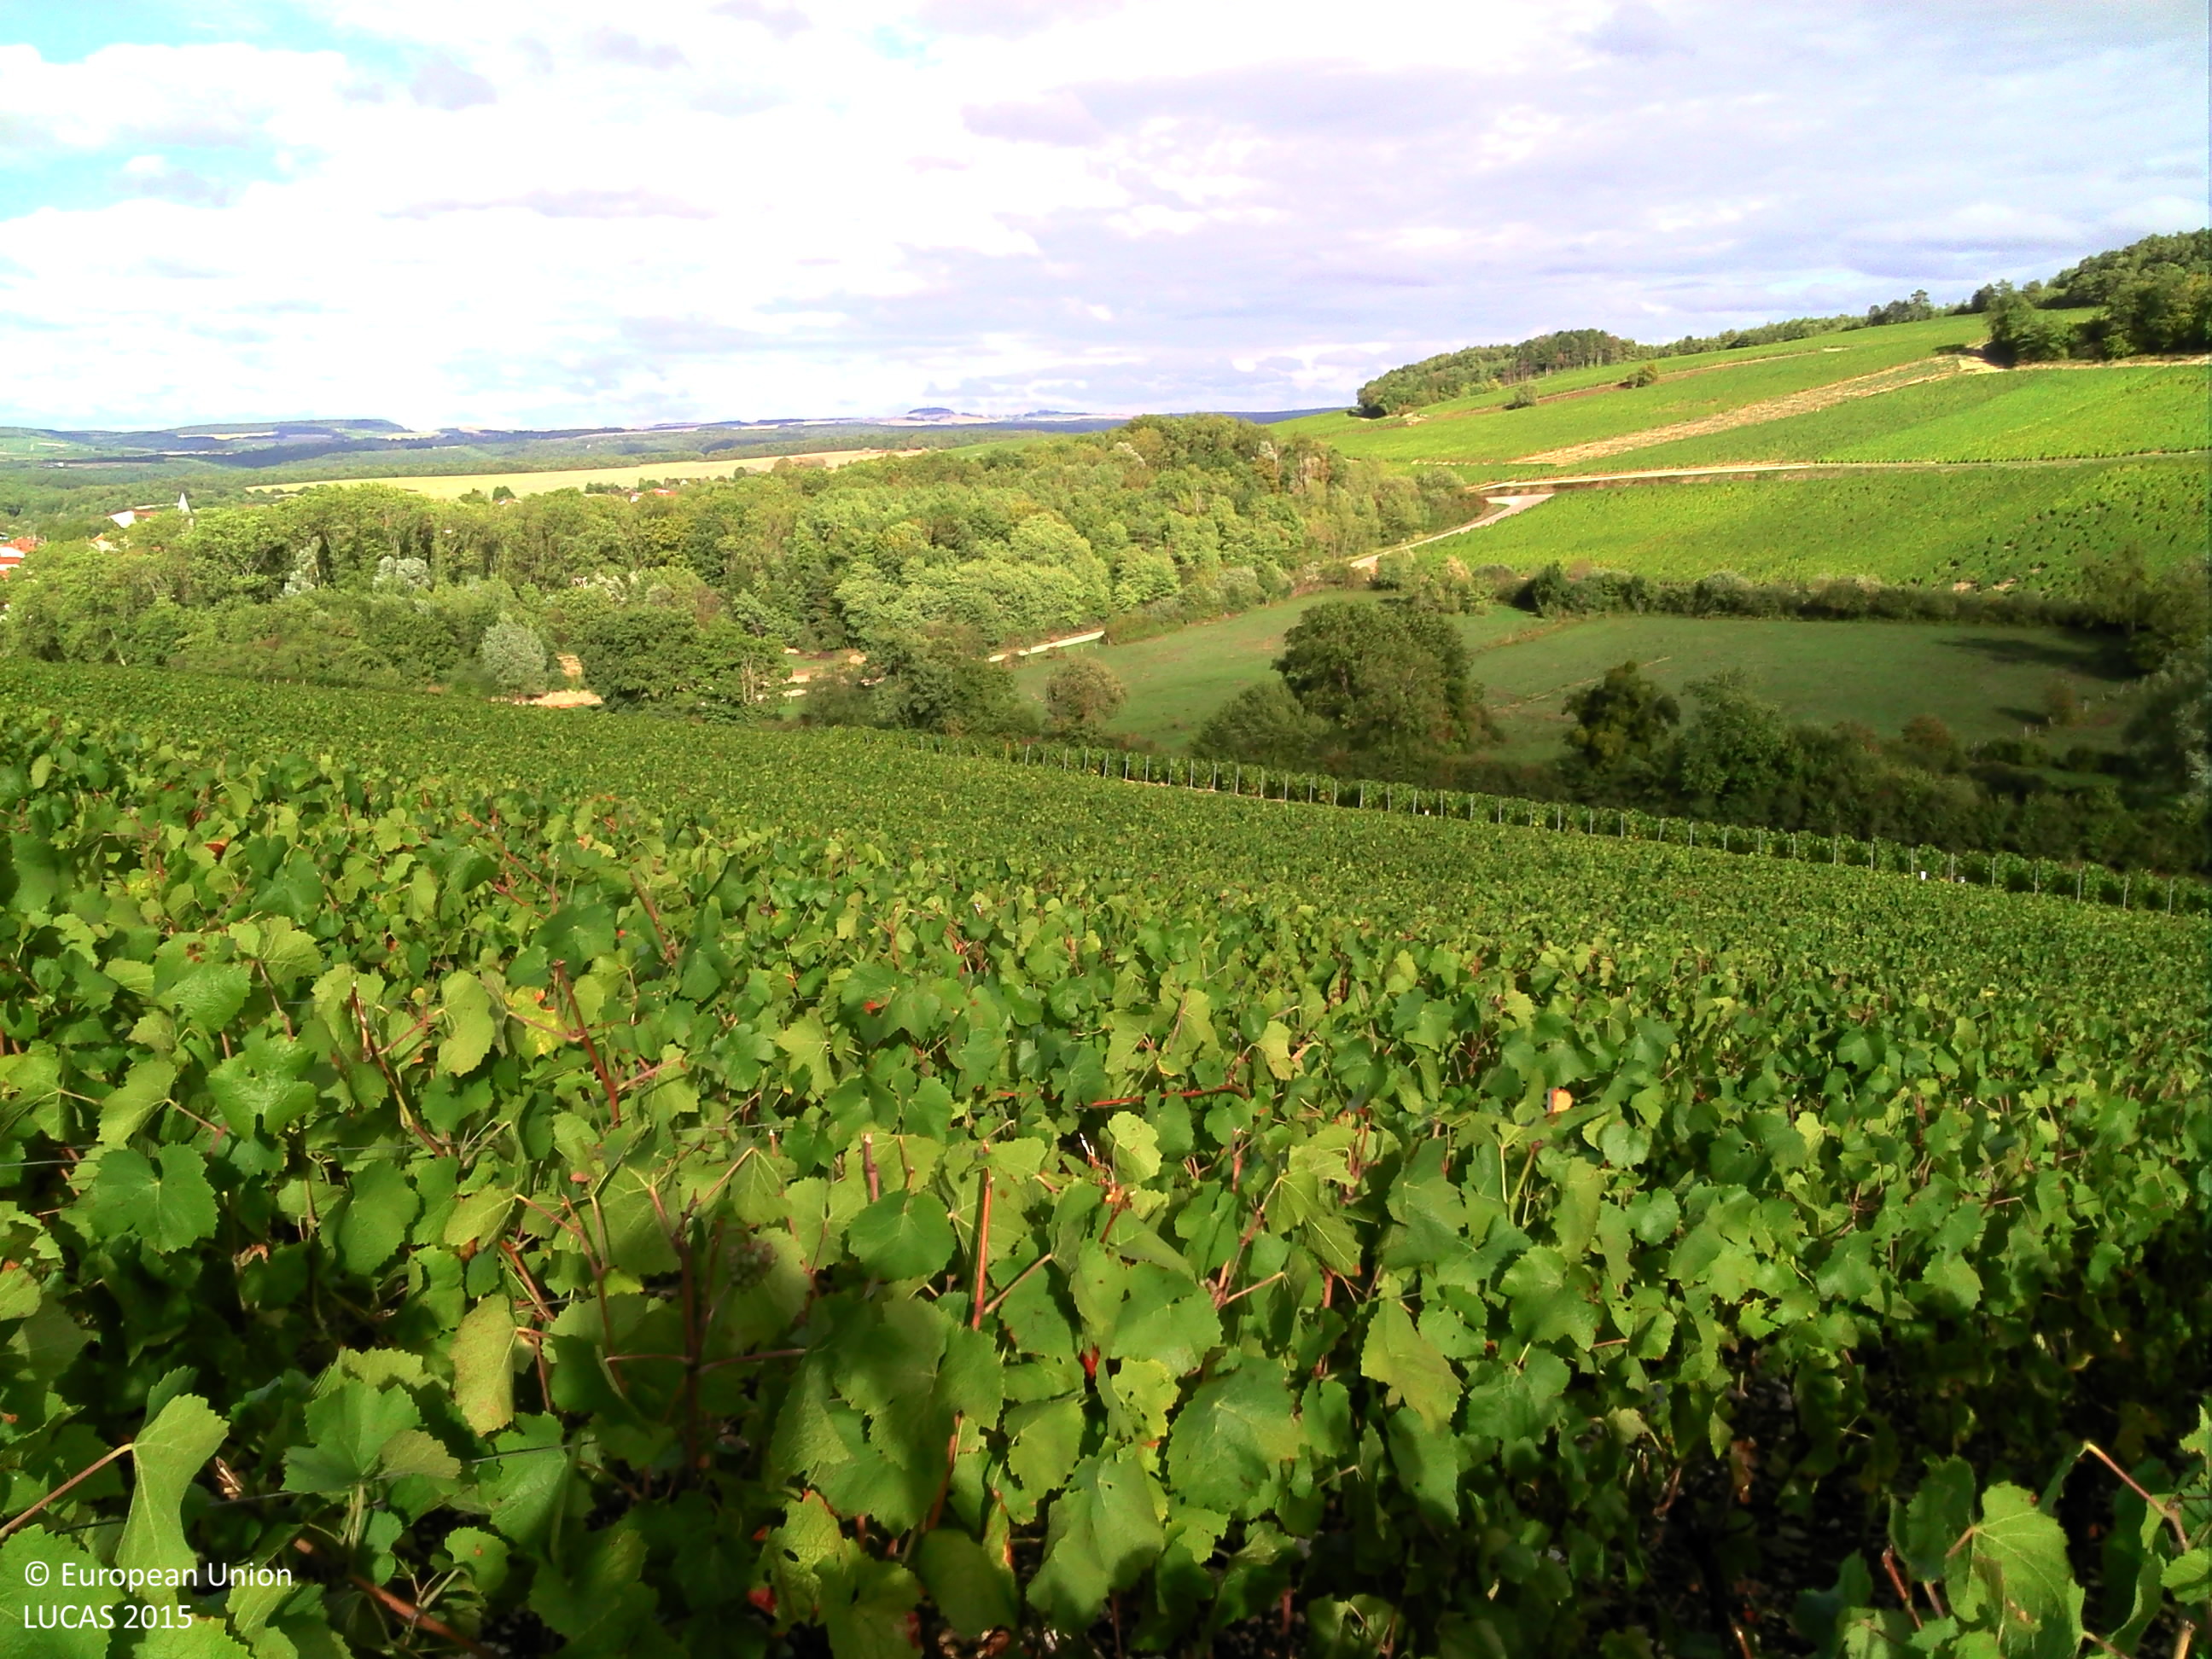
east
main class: Cropland
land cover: Vineyards
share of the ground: 25 - 50 %
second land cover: Other bare soil
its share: > 75 %
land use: Agriculture (excluding fallow land and kitchen gardens)
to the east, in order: Vineyards; Other bare soil; Tracks; Vineyards; Tracks; Grass margins; Ditches and canals; Fences; Managed hedges; Grassland without tree/shrub cover; Broadleaved woodland; Grassland without tree/shrub cover
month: September
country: FR
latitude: 48.1868
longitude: 4.7119
